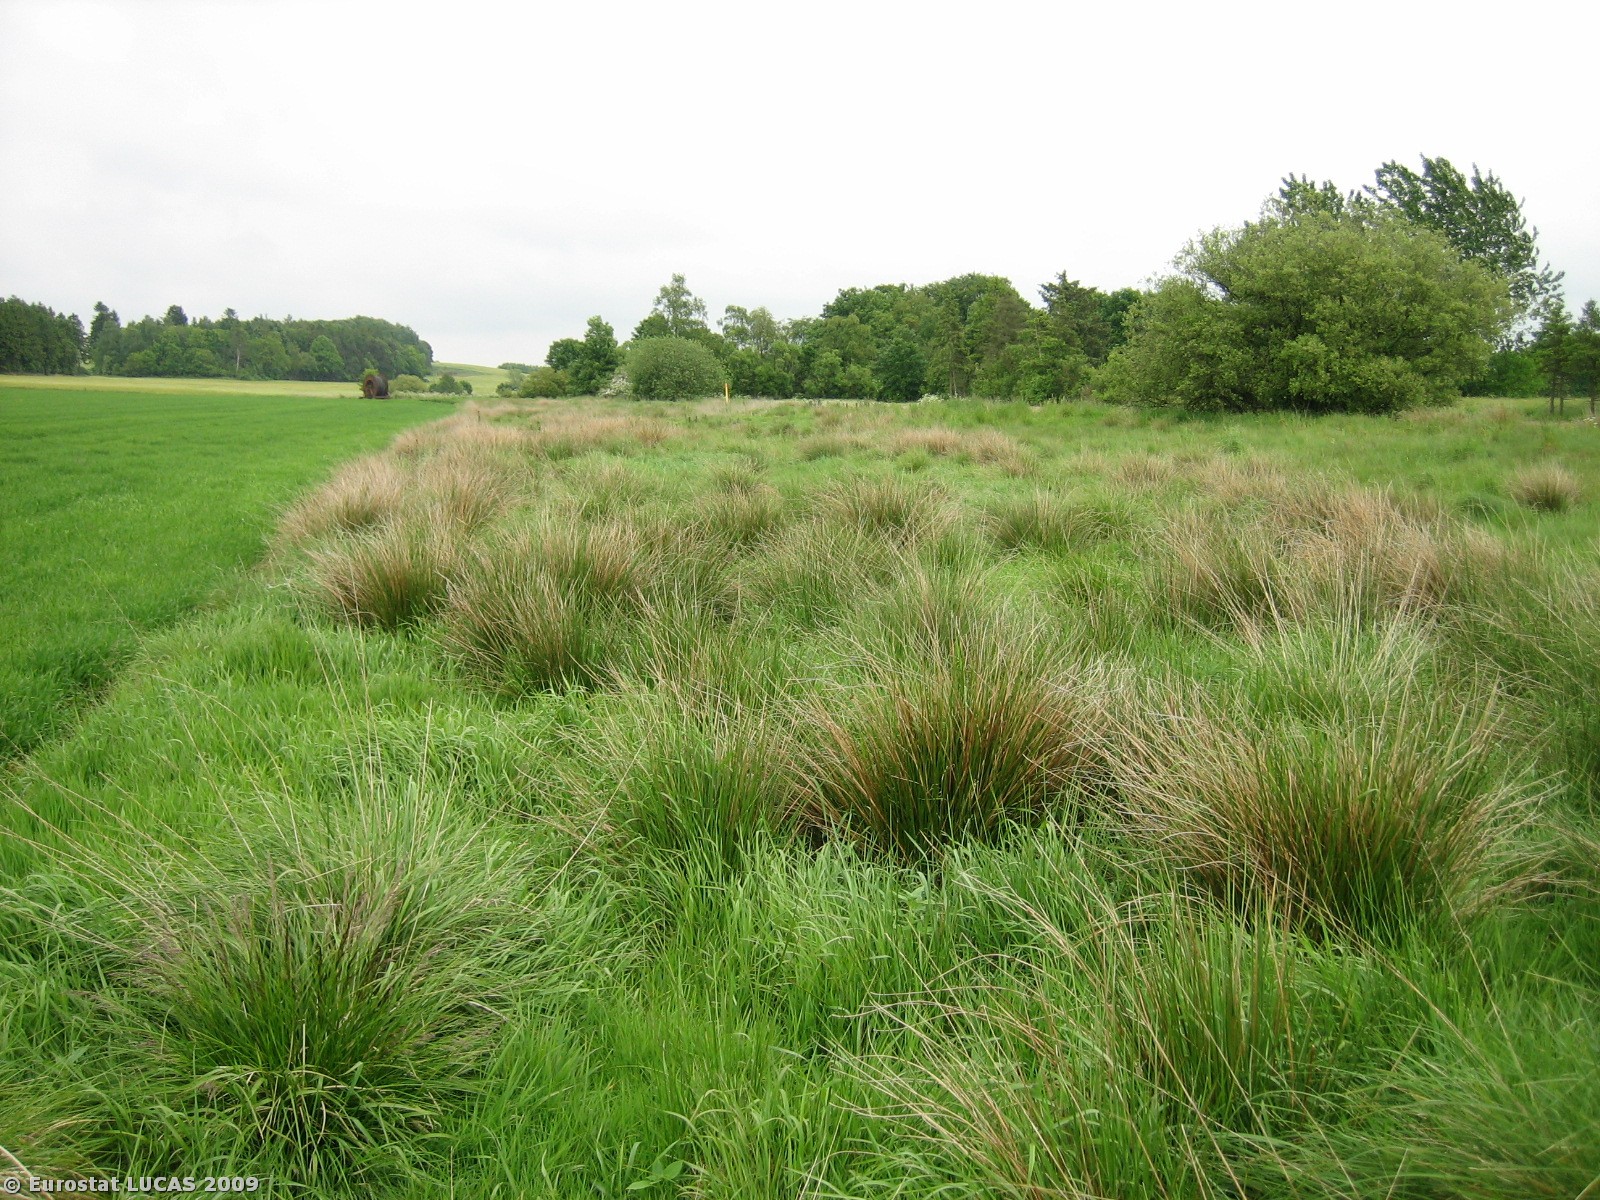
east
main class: Grassland
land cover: Grassland without tree/shrub cover
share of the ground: > 75 %
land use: Unused
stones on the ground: < 10 %
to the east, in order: Grassland without tree/shrub cover; Ditches and canals; Fences; Grassland without tree/shrub cover; Broadleaved woodland; Grassland without tree/shrub cover; Tracks; Grassland without tree/shrub cover; Tracks
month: May
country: DK
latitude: 55.8616
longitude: 9.1860
